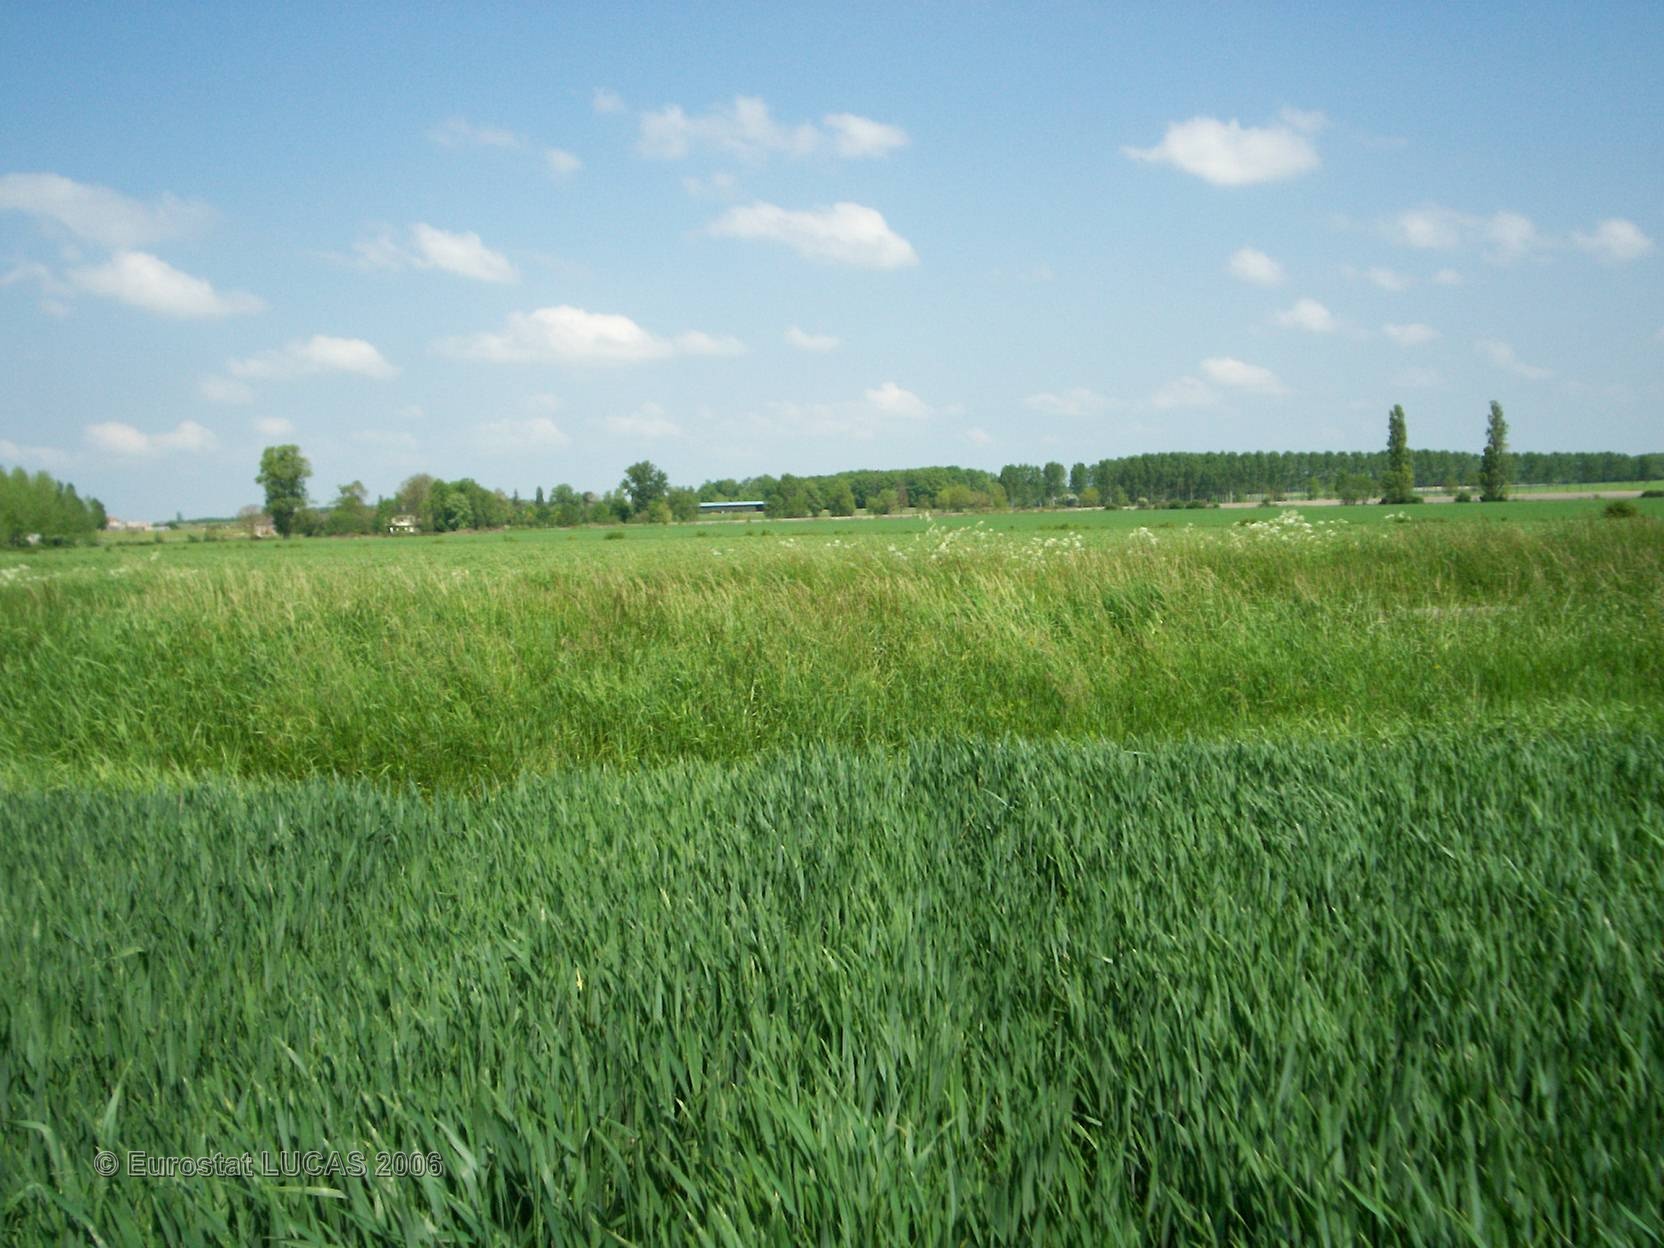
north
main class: Cropland
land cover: Common wheat
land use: Agriculture (excluding fallow land and kitchen gardens)
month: May
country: FR
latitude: 47.4465
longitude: 0.2557
